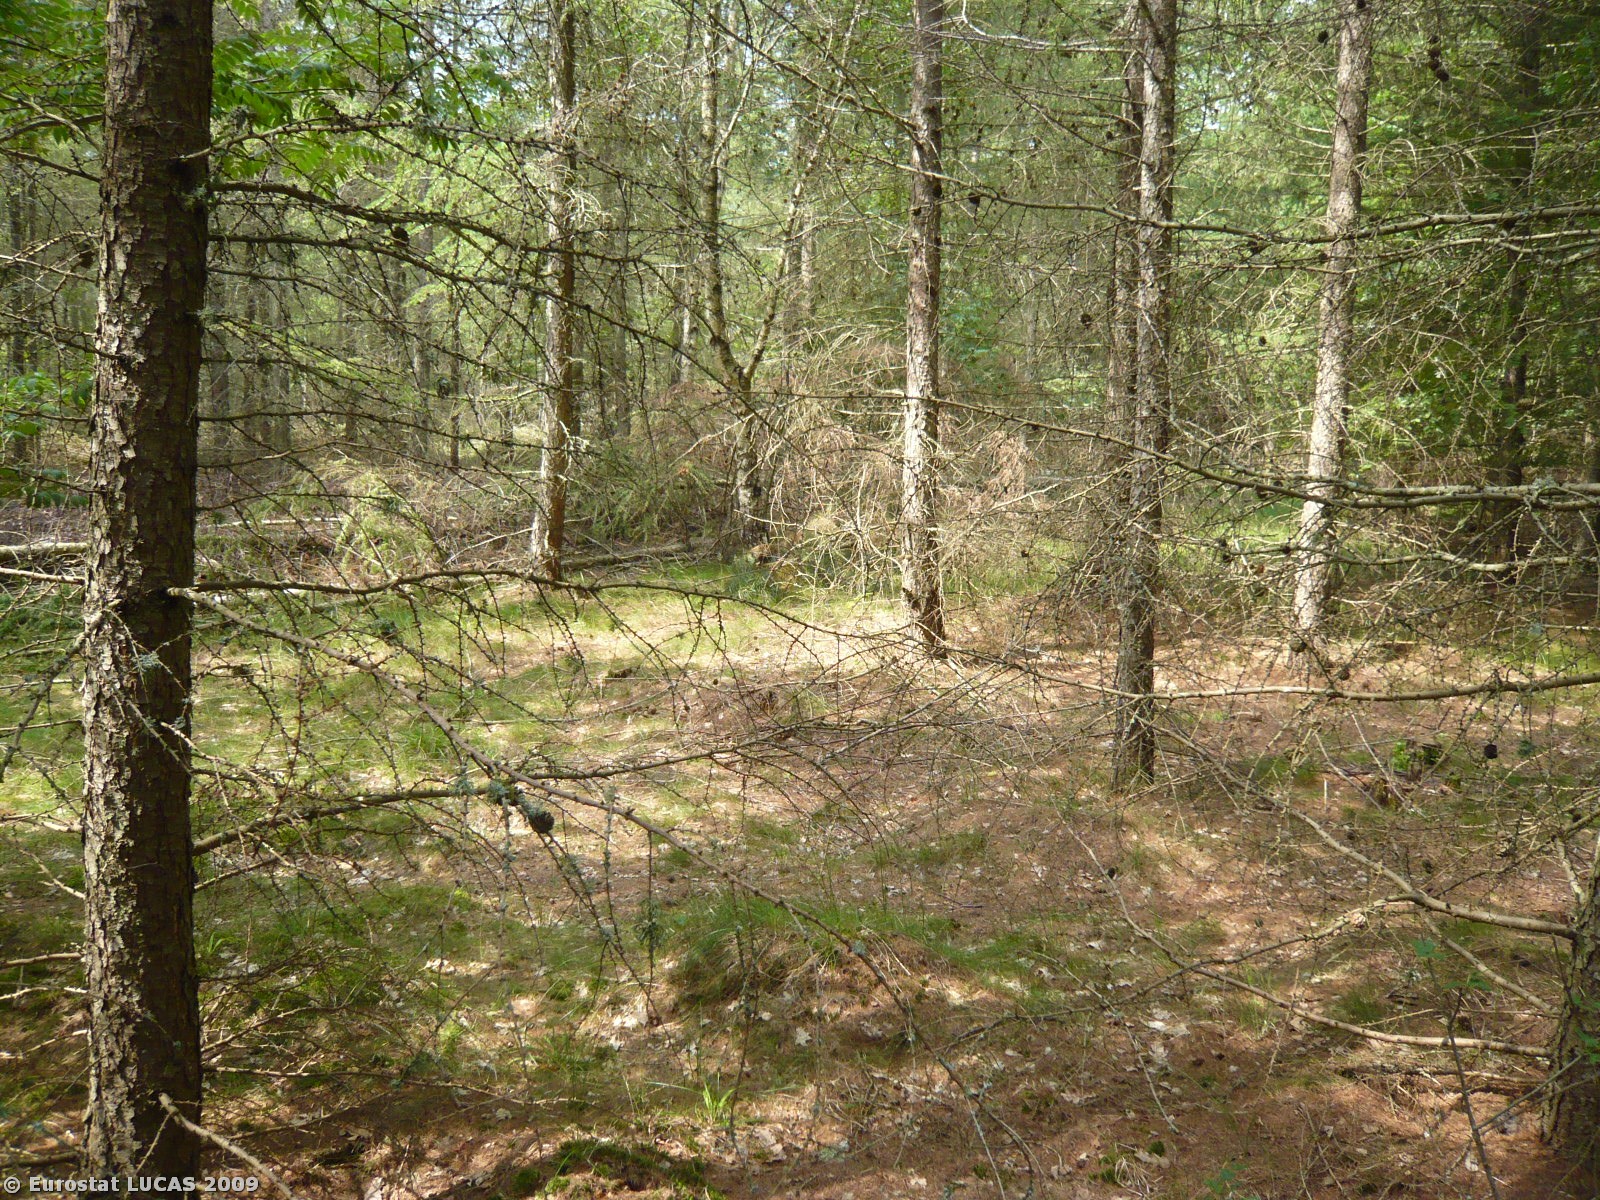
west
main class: Woodland
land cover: Coniferous woodland
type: hemiboreal forest and nemoral coniferous forest and mixed broadleaved-coniferous forest
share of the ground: > 75 %
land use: Forestry
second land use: Amenities, museums, leisure
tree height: > 5 m
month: August
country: DK
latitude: 56.0447
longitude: 12.1009
